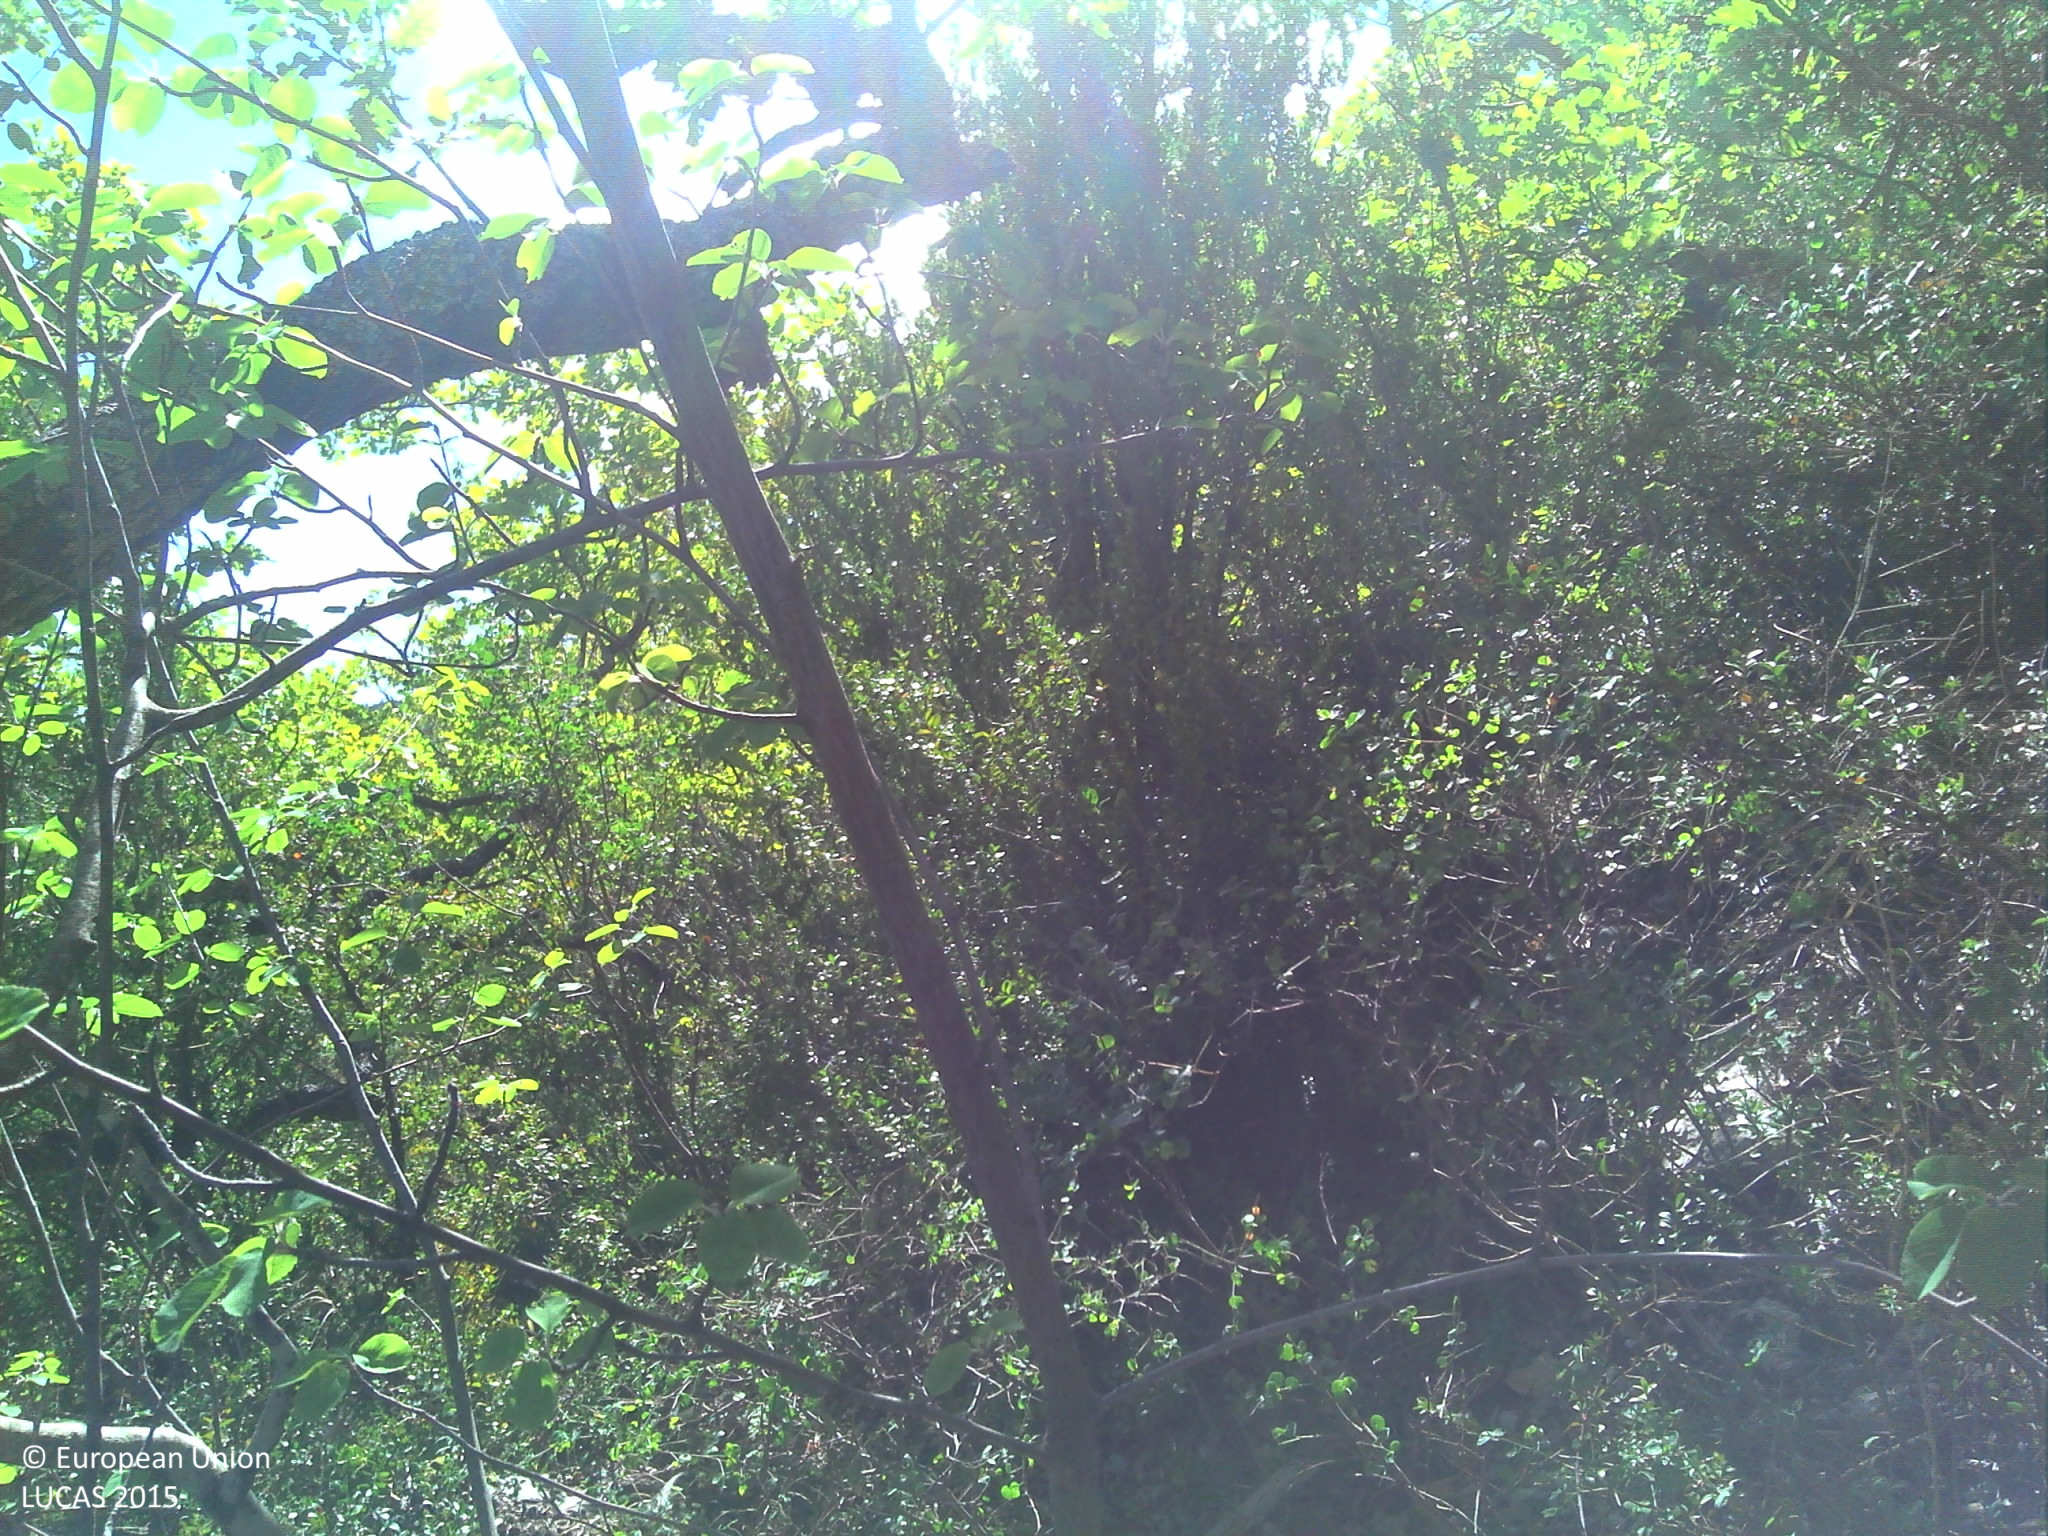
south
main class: Woodland
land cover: Broadleaved woodland
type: thermophilous deciduous forest
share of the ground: > 75 %
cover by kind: broadleaved forest trees 90 %, coniferous forest trees 5 %, herbaceous plants 5 %
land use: Semi-natural and natural areas not in use
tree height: > 5 m
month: September
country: FR
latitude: 44.2458
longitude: 5.3367
